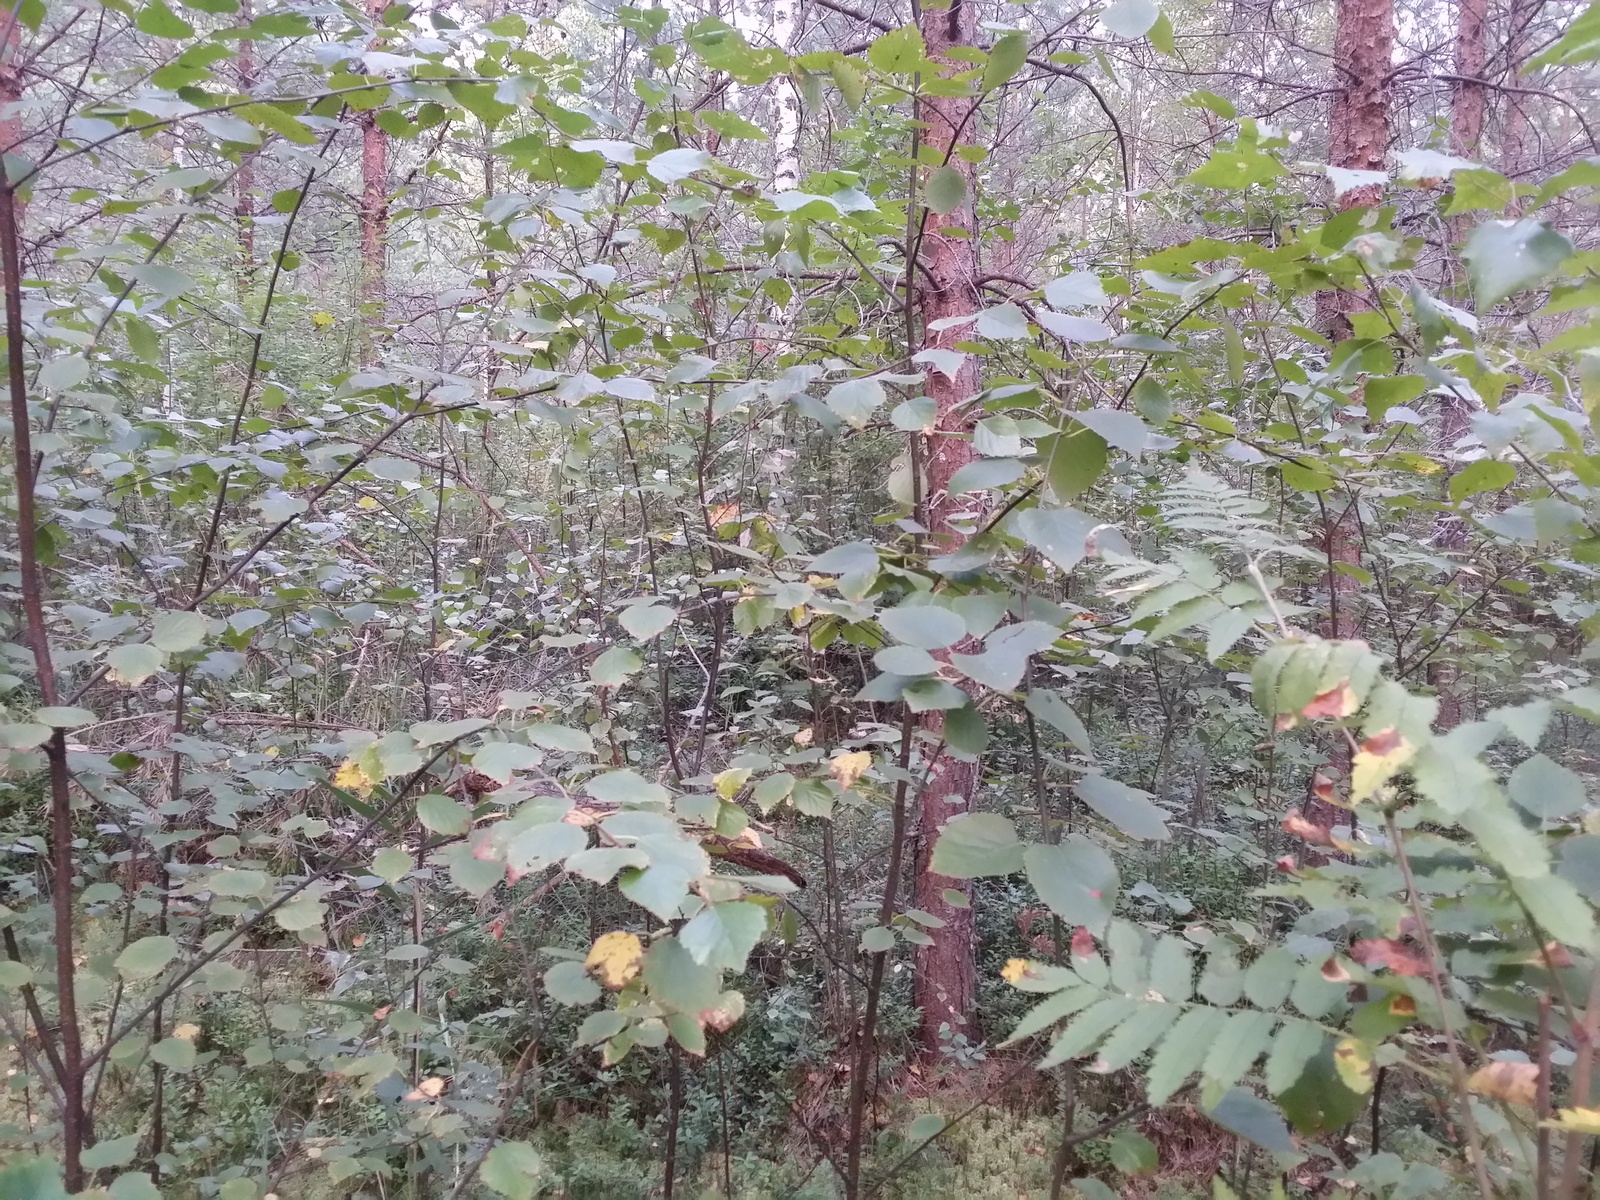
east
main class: Woodland
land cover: Pine dominated mixed woodland
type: hemiboreal forest and nemoral coniferous forest and mixed broadleaved-coniferous forest
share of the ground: > 75 %
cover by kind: coniferous forest trees 35 %, broadleaved forest trees 30 %, herbaceous plants 20 %, shrubs 10 %, lichens and mosses 5 %
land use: Forestry
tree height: > 5 m
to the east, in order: Pine dominated mixed woodland; Paved roads, cycling and walking lanes; Broadleaved woodland; Shrubland with sparse tree cover; Ditches and canals; Abandoned hedges; Spontaneously vegetated surfaces; Spruce dominated mixed woodland
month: August
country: LV
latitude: 56.9822
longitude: 27.2317
